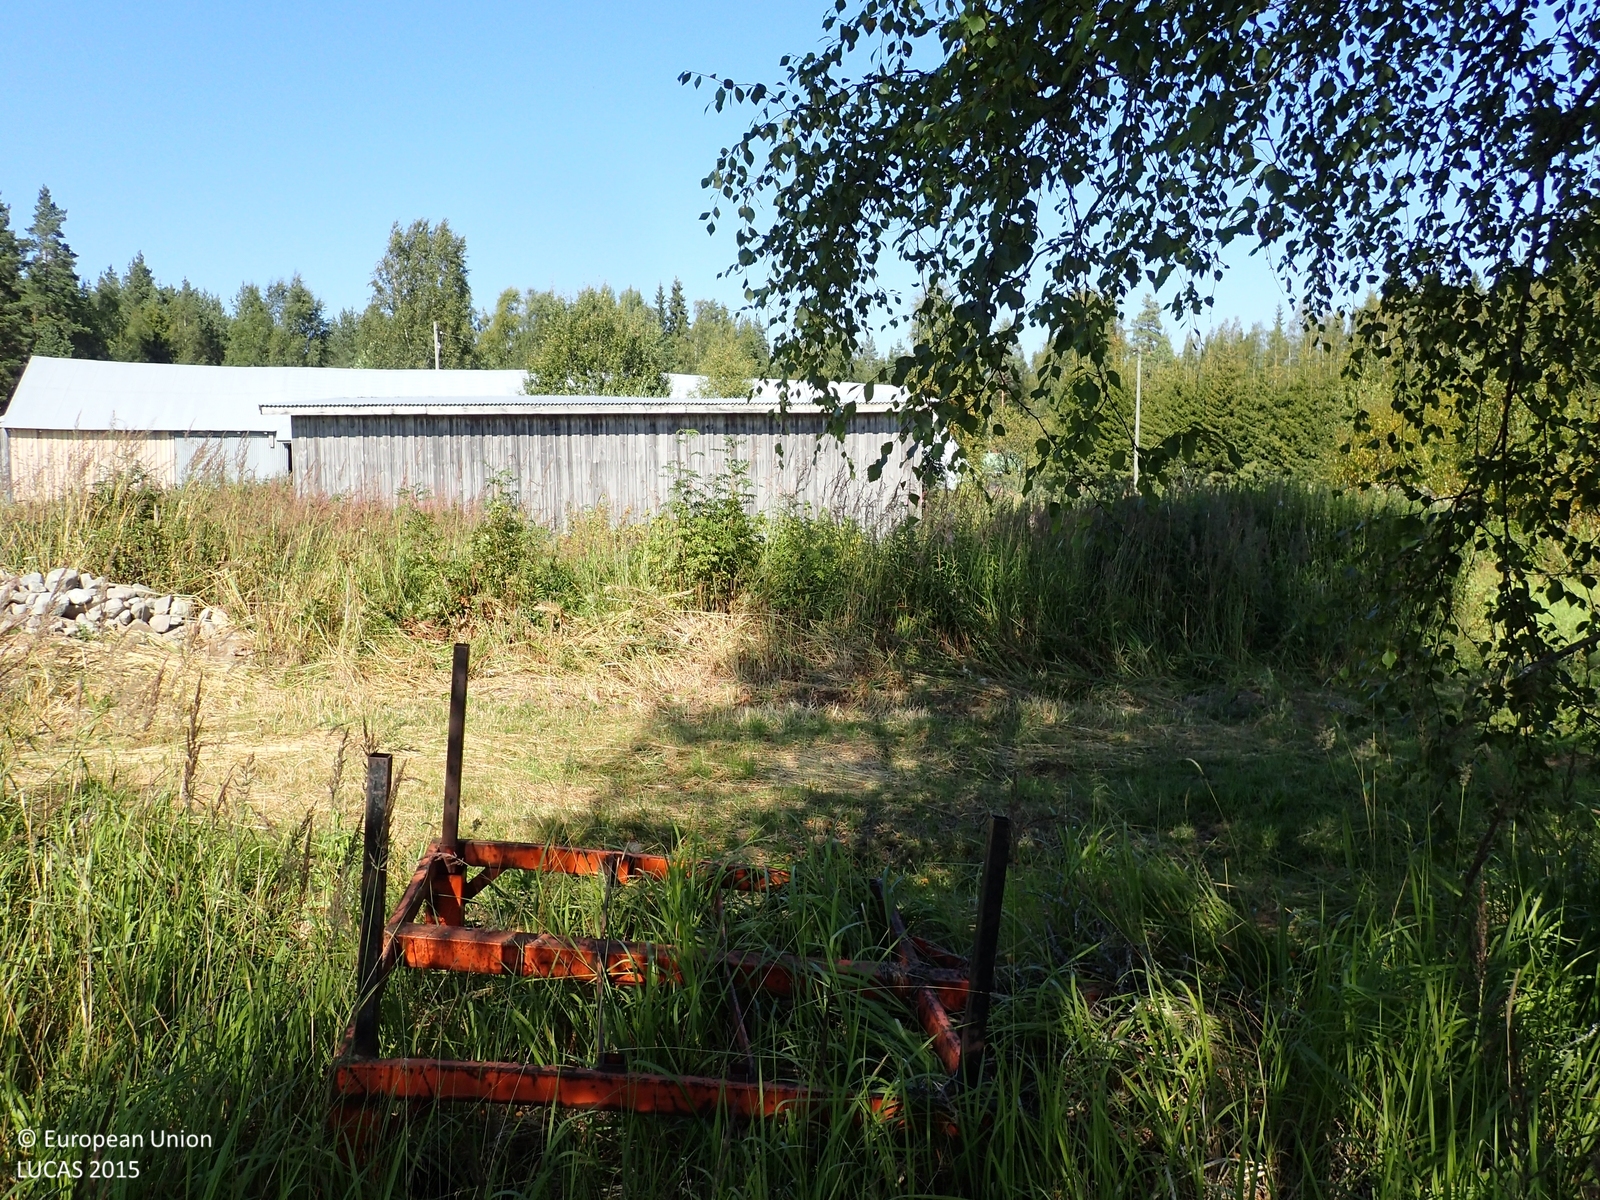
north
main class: Woodland
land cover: Broadleaved woodland
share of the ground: 25 - 50 %
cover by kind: herbaceous plants 60 %, broadleaved forest trees 40 %
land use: Residential
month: August
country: FI
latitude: 62.3261
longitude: 21.8410
